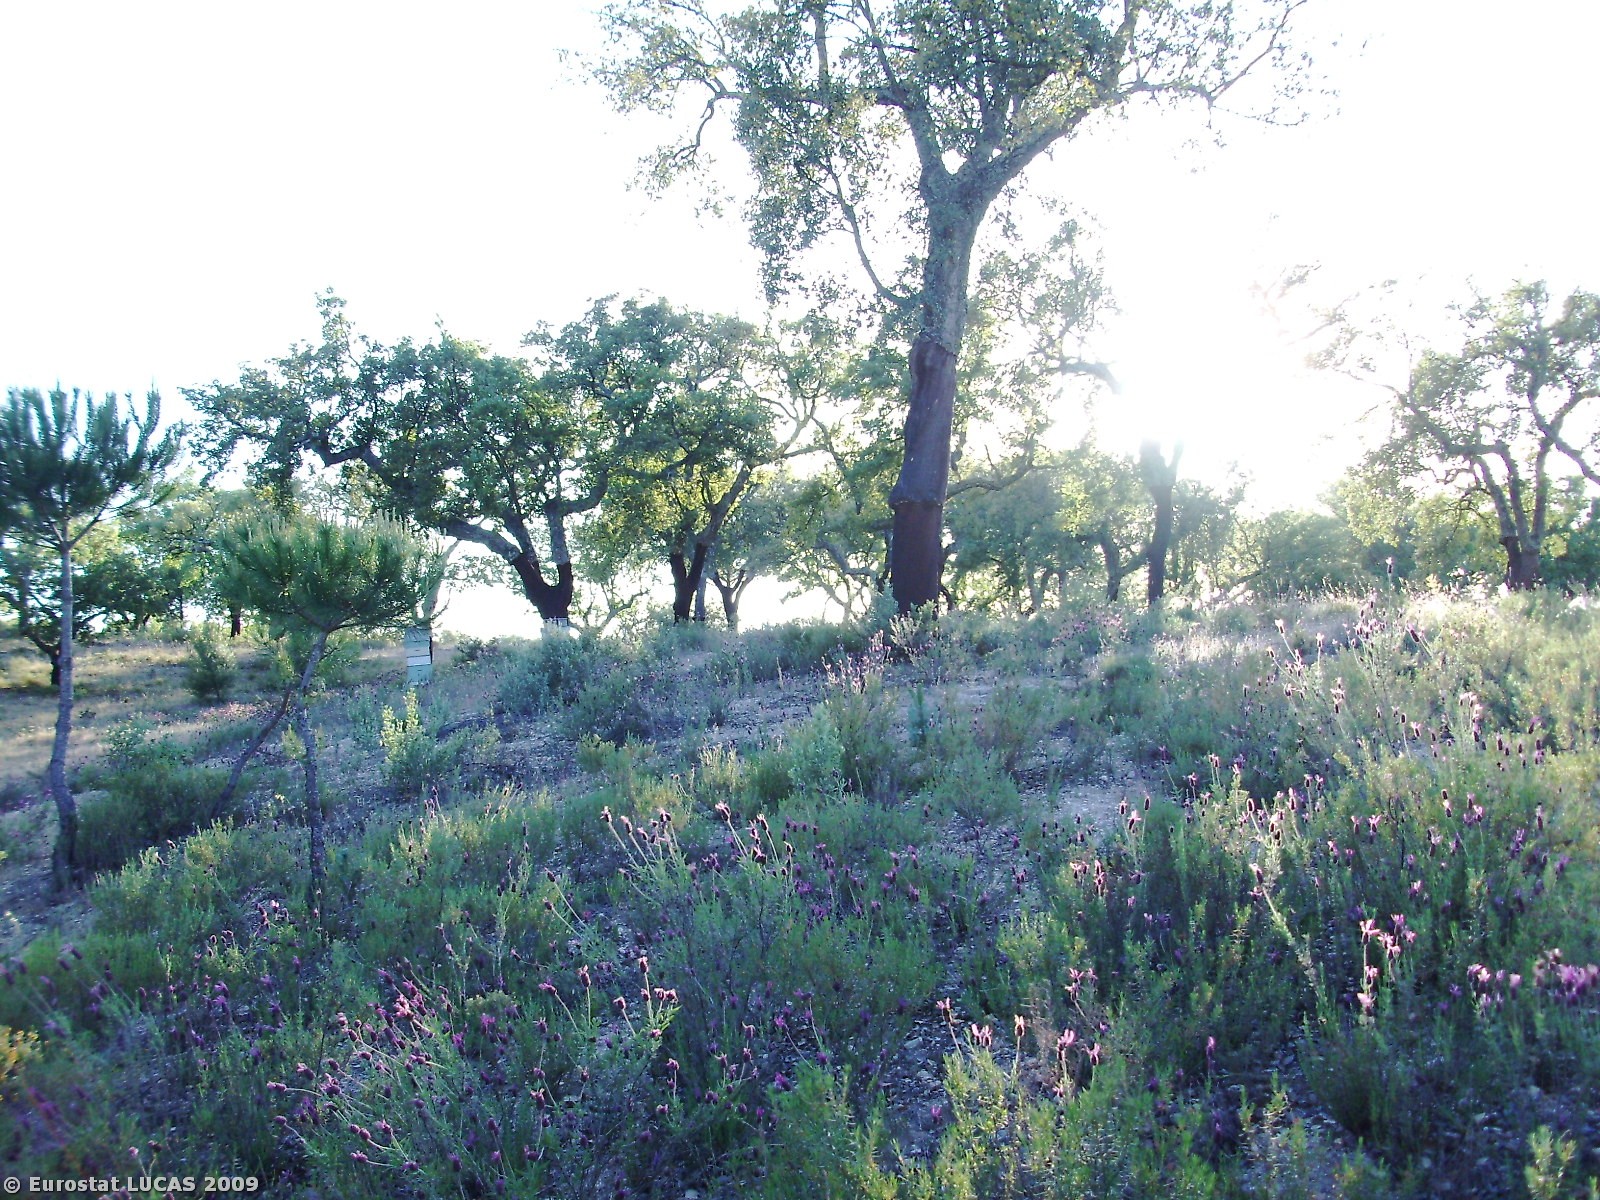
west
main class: Woodland
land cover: Broadleaved woodland
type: broadleaved evergreen forest
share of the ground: 25 - 50 %
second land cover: Spontaneously vegetated surfaces
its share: 50 - 75 %
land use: Forestry
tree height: > 5 m
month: May
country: PT
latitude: 39.1989
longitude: -7.9895
